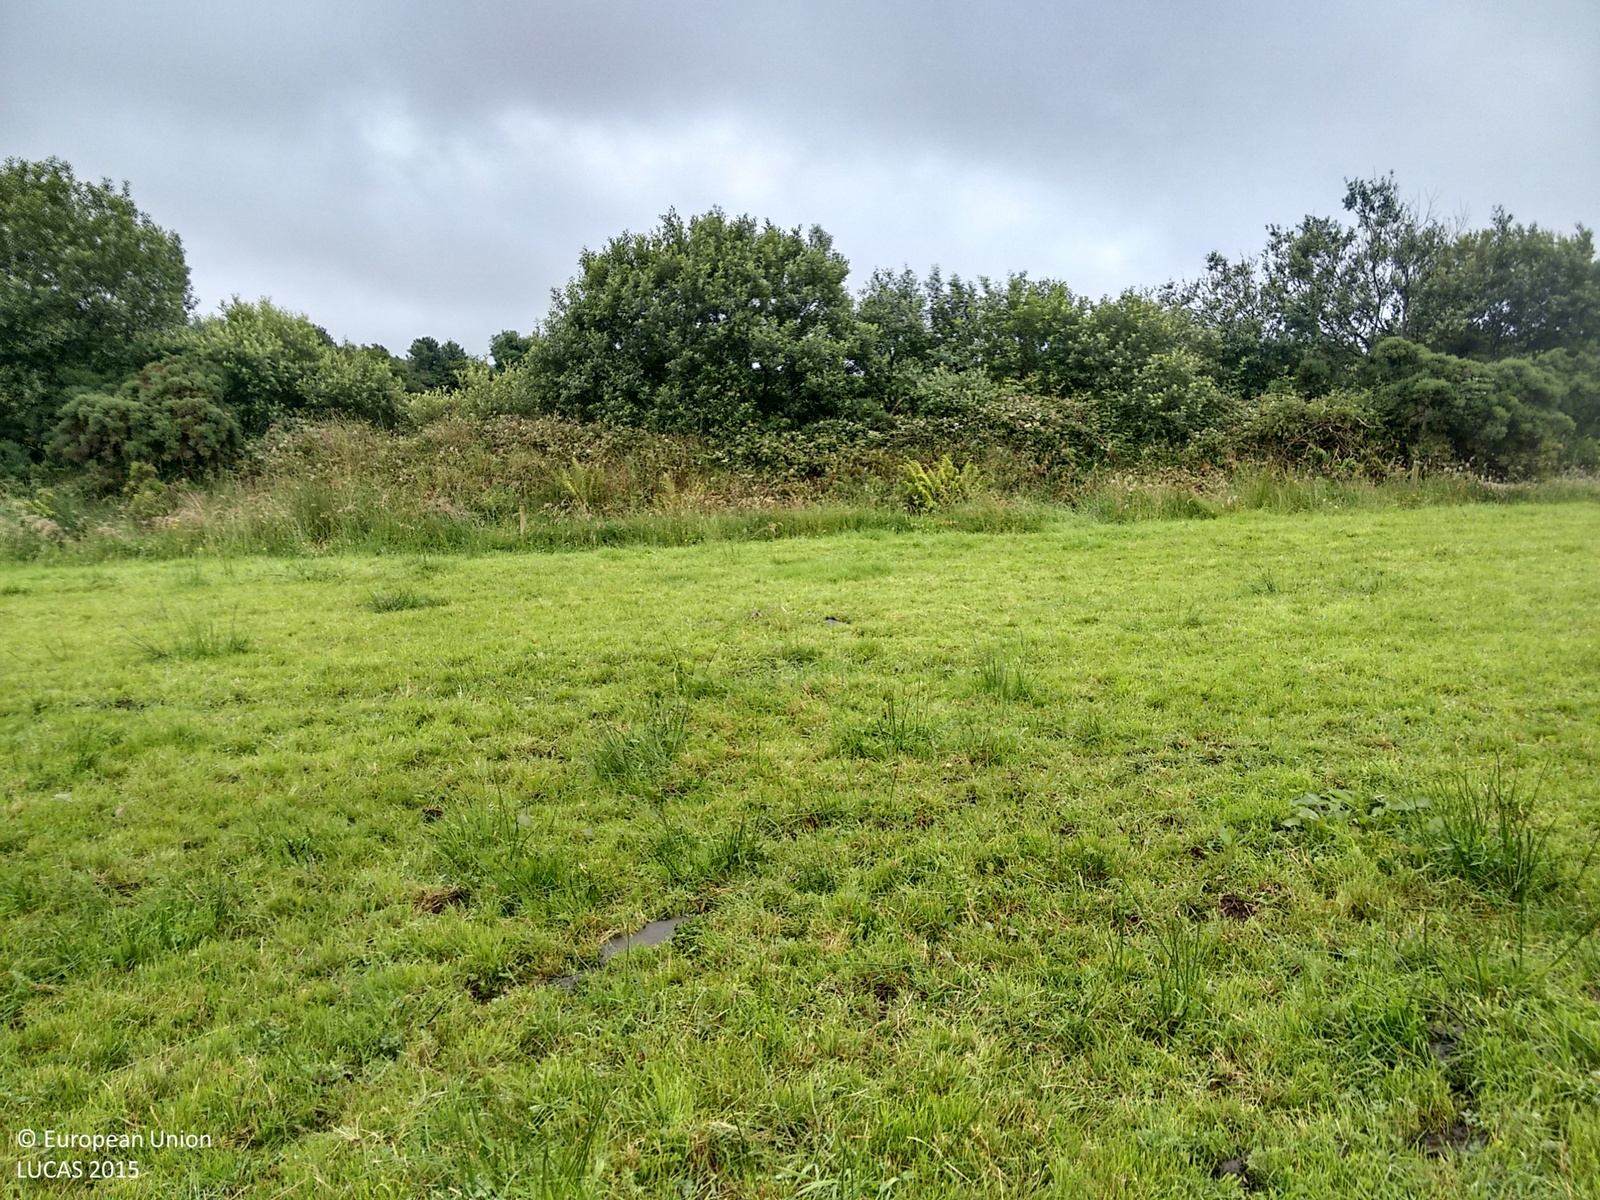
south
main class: Grassland
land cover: Grassland without tree/shrub cover
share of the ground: > 75 %
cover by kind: herbaceous plants 100 %
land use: Agriculture (excluding fallow land and kitchen gardens)
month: July
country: IE
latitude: 52.0859
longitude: -8.3885
